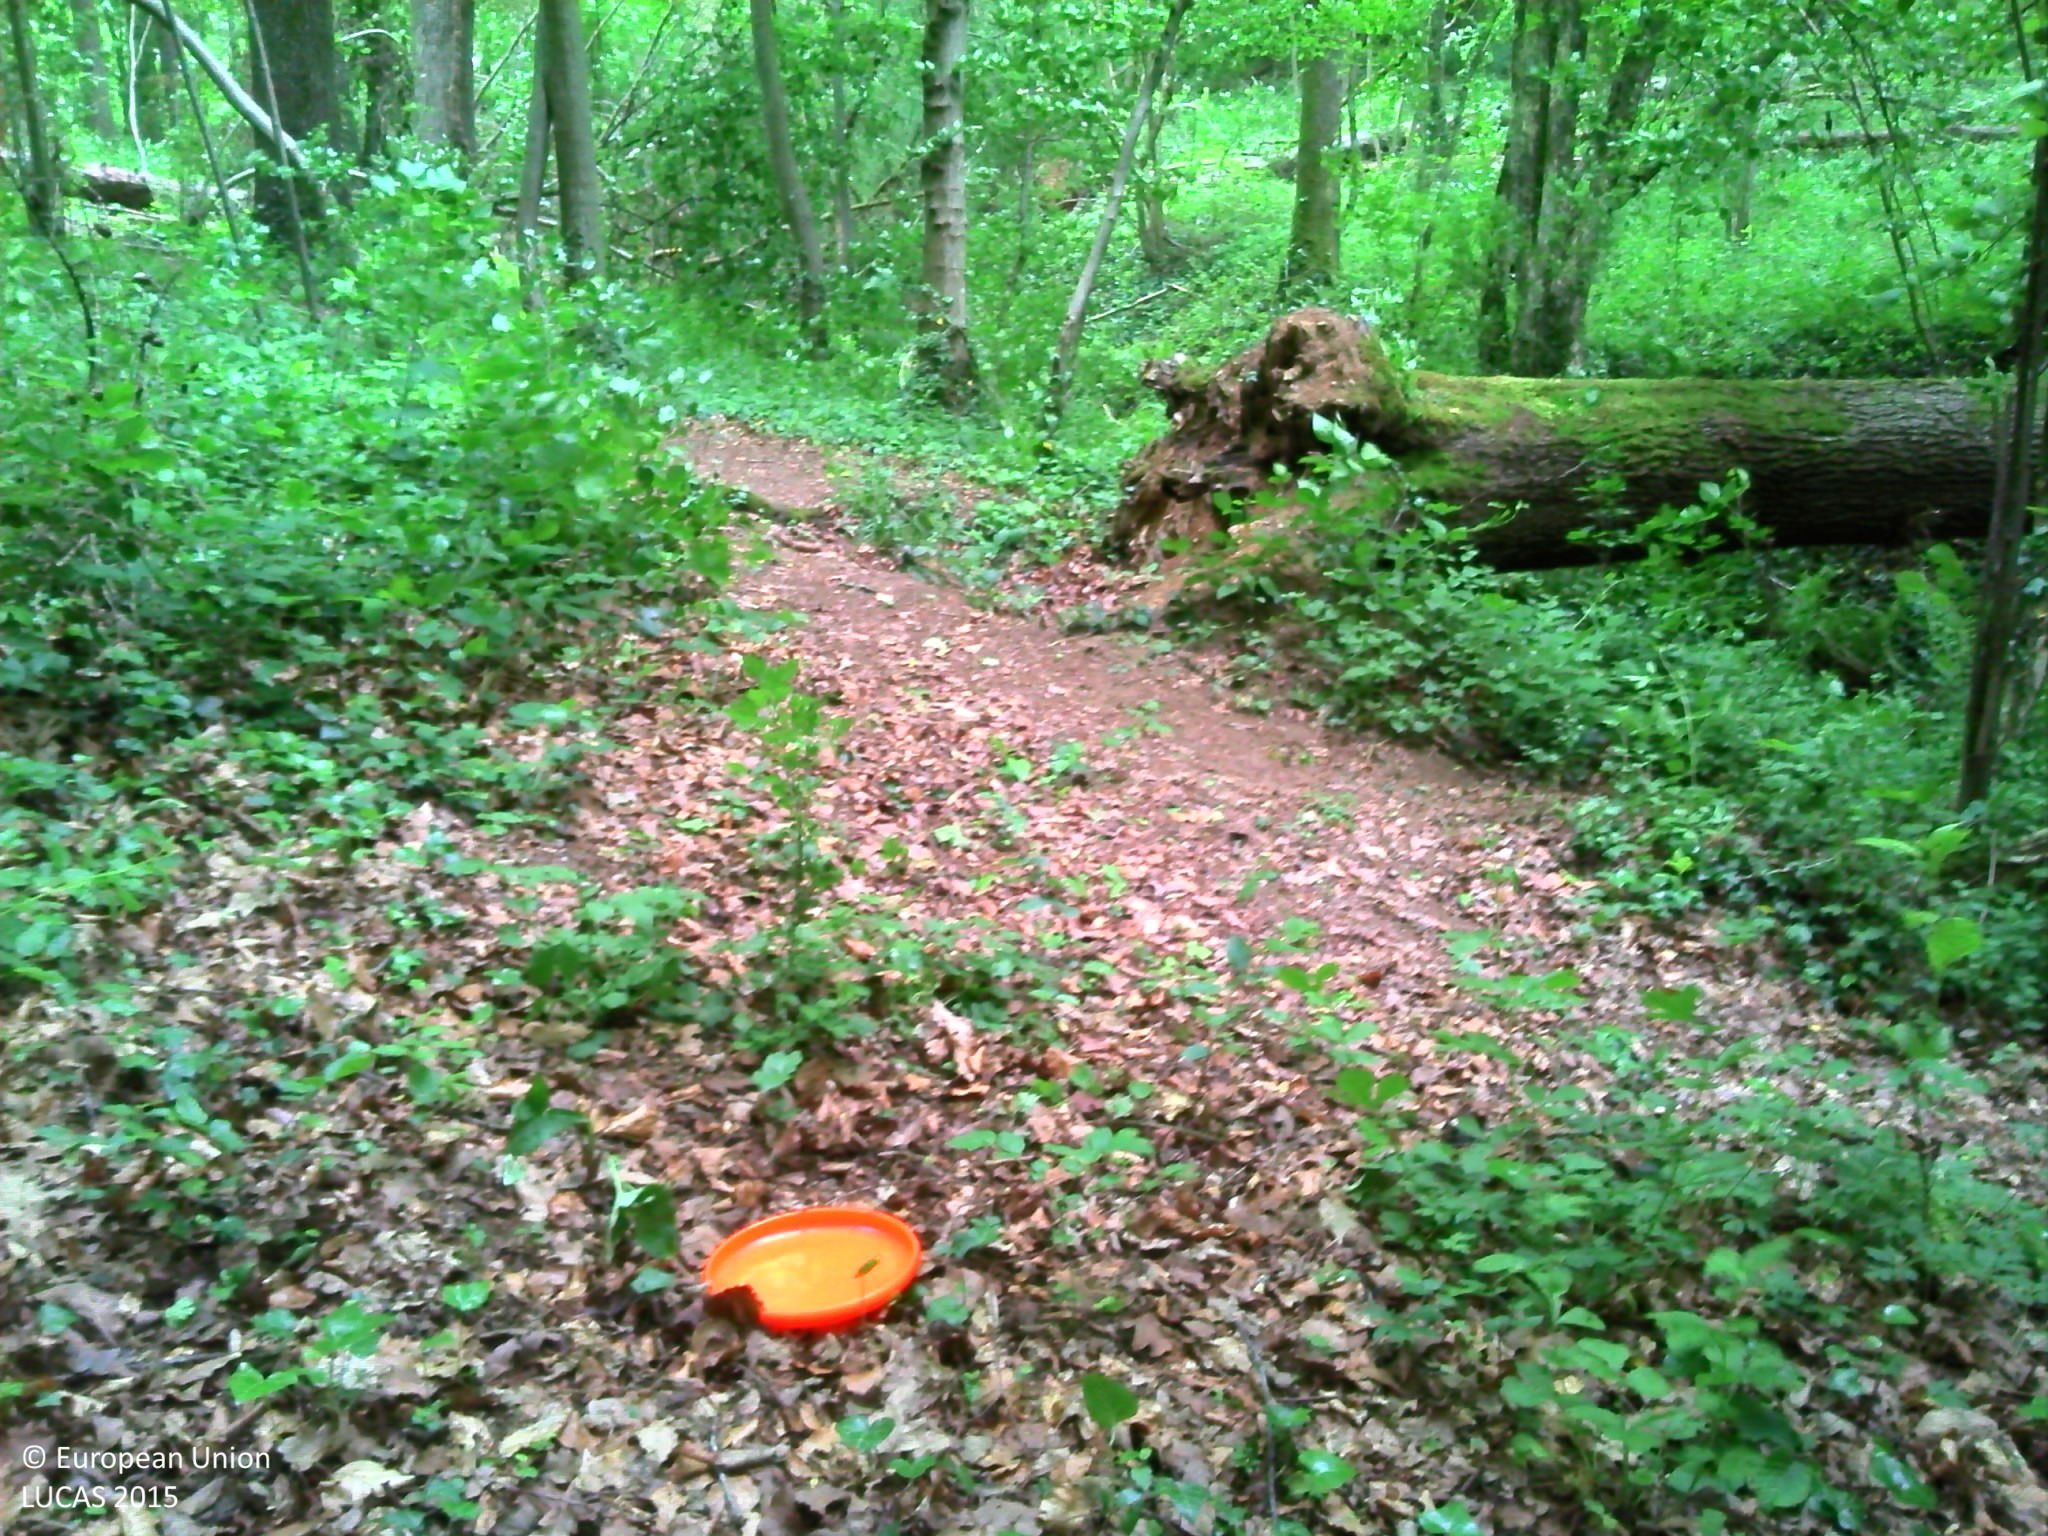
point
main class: Woodland
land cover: Broadleaved woodland
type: acidophilous oak and oak-birch forest
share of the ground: > 75 %
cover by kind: broadleaved forest trees 90 %, herbaceous plants 10 %
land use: Forestry
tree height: > 5 m
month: June
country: BE
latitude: 50.4031
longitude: 5.5383
